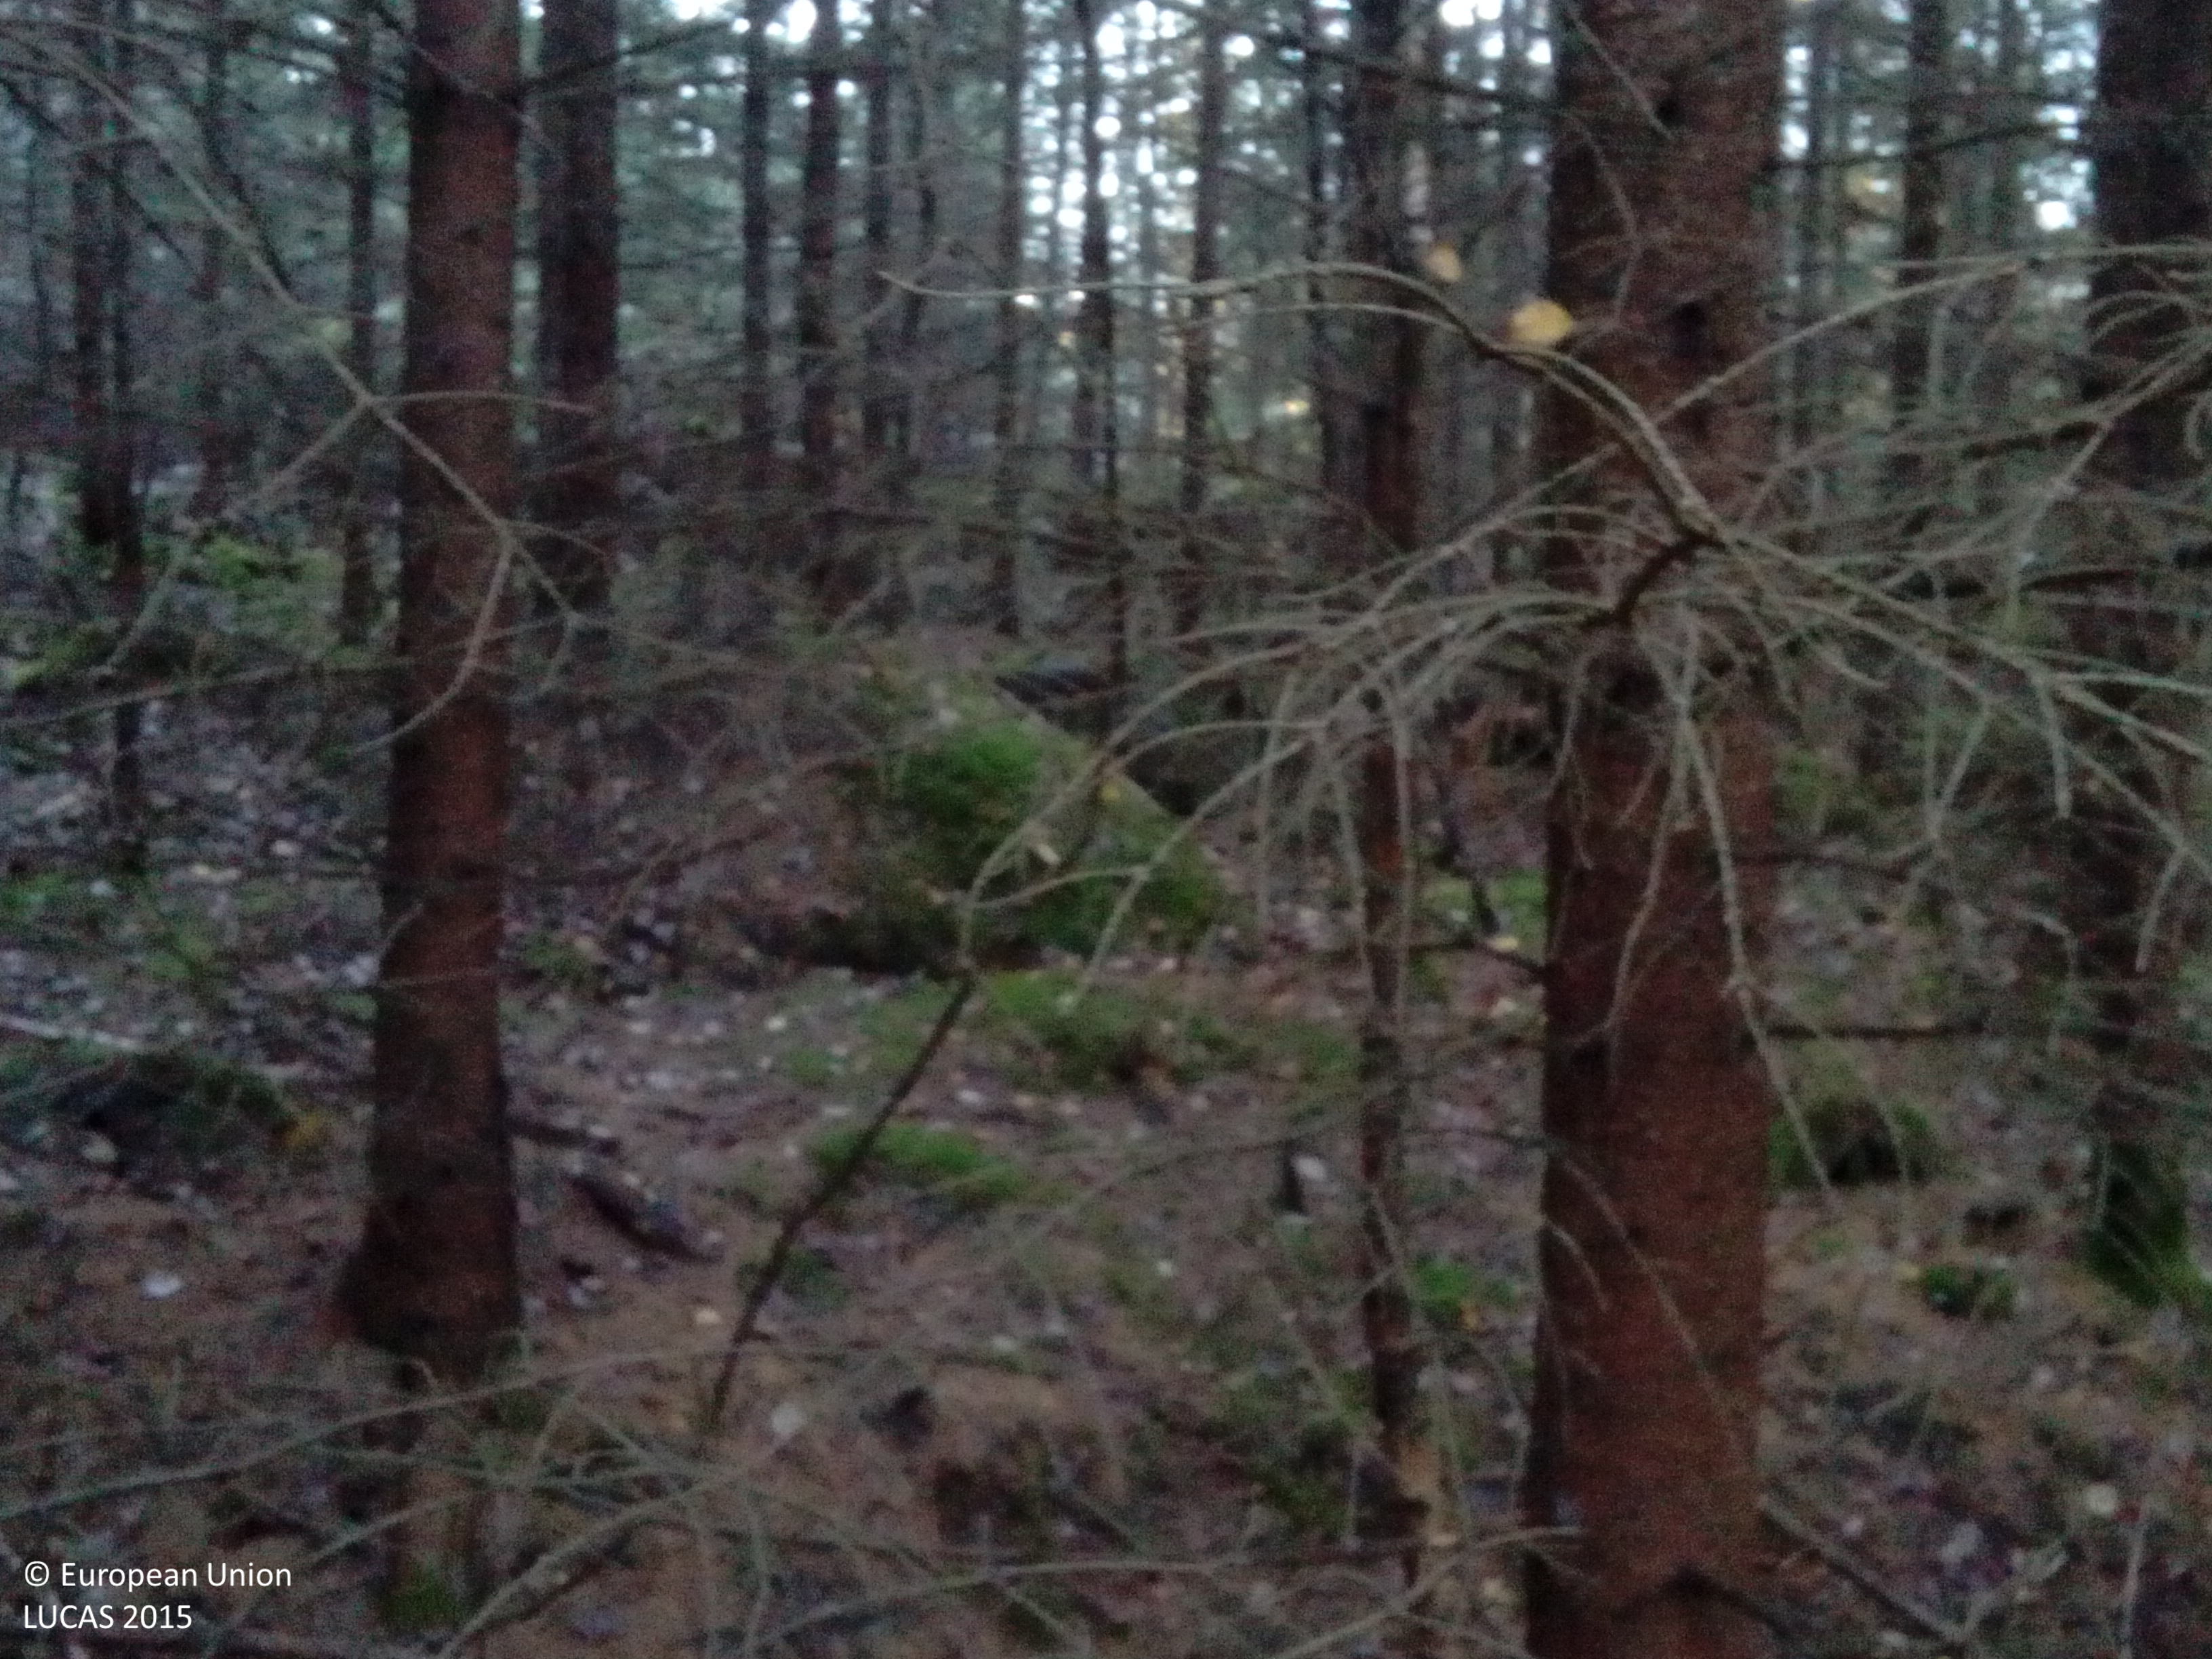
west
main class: Woodland
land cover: Spruce dominated coniferous woodland
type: boreal forest
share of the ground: > 75 %
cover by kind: coniferous forest trees 85 %, lichens and mosses 10 %, herbaceous plants 5 %
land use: Forestry
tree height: > 5 m
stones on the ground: < 10 %
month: October
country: SE
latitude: 59.0913
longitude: 16.5043
